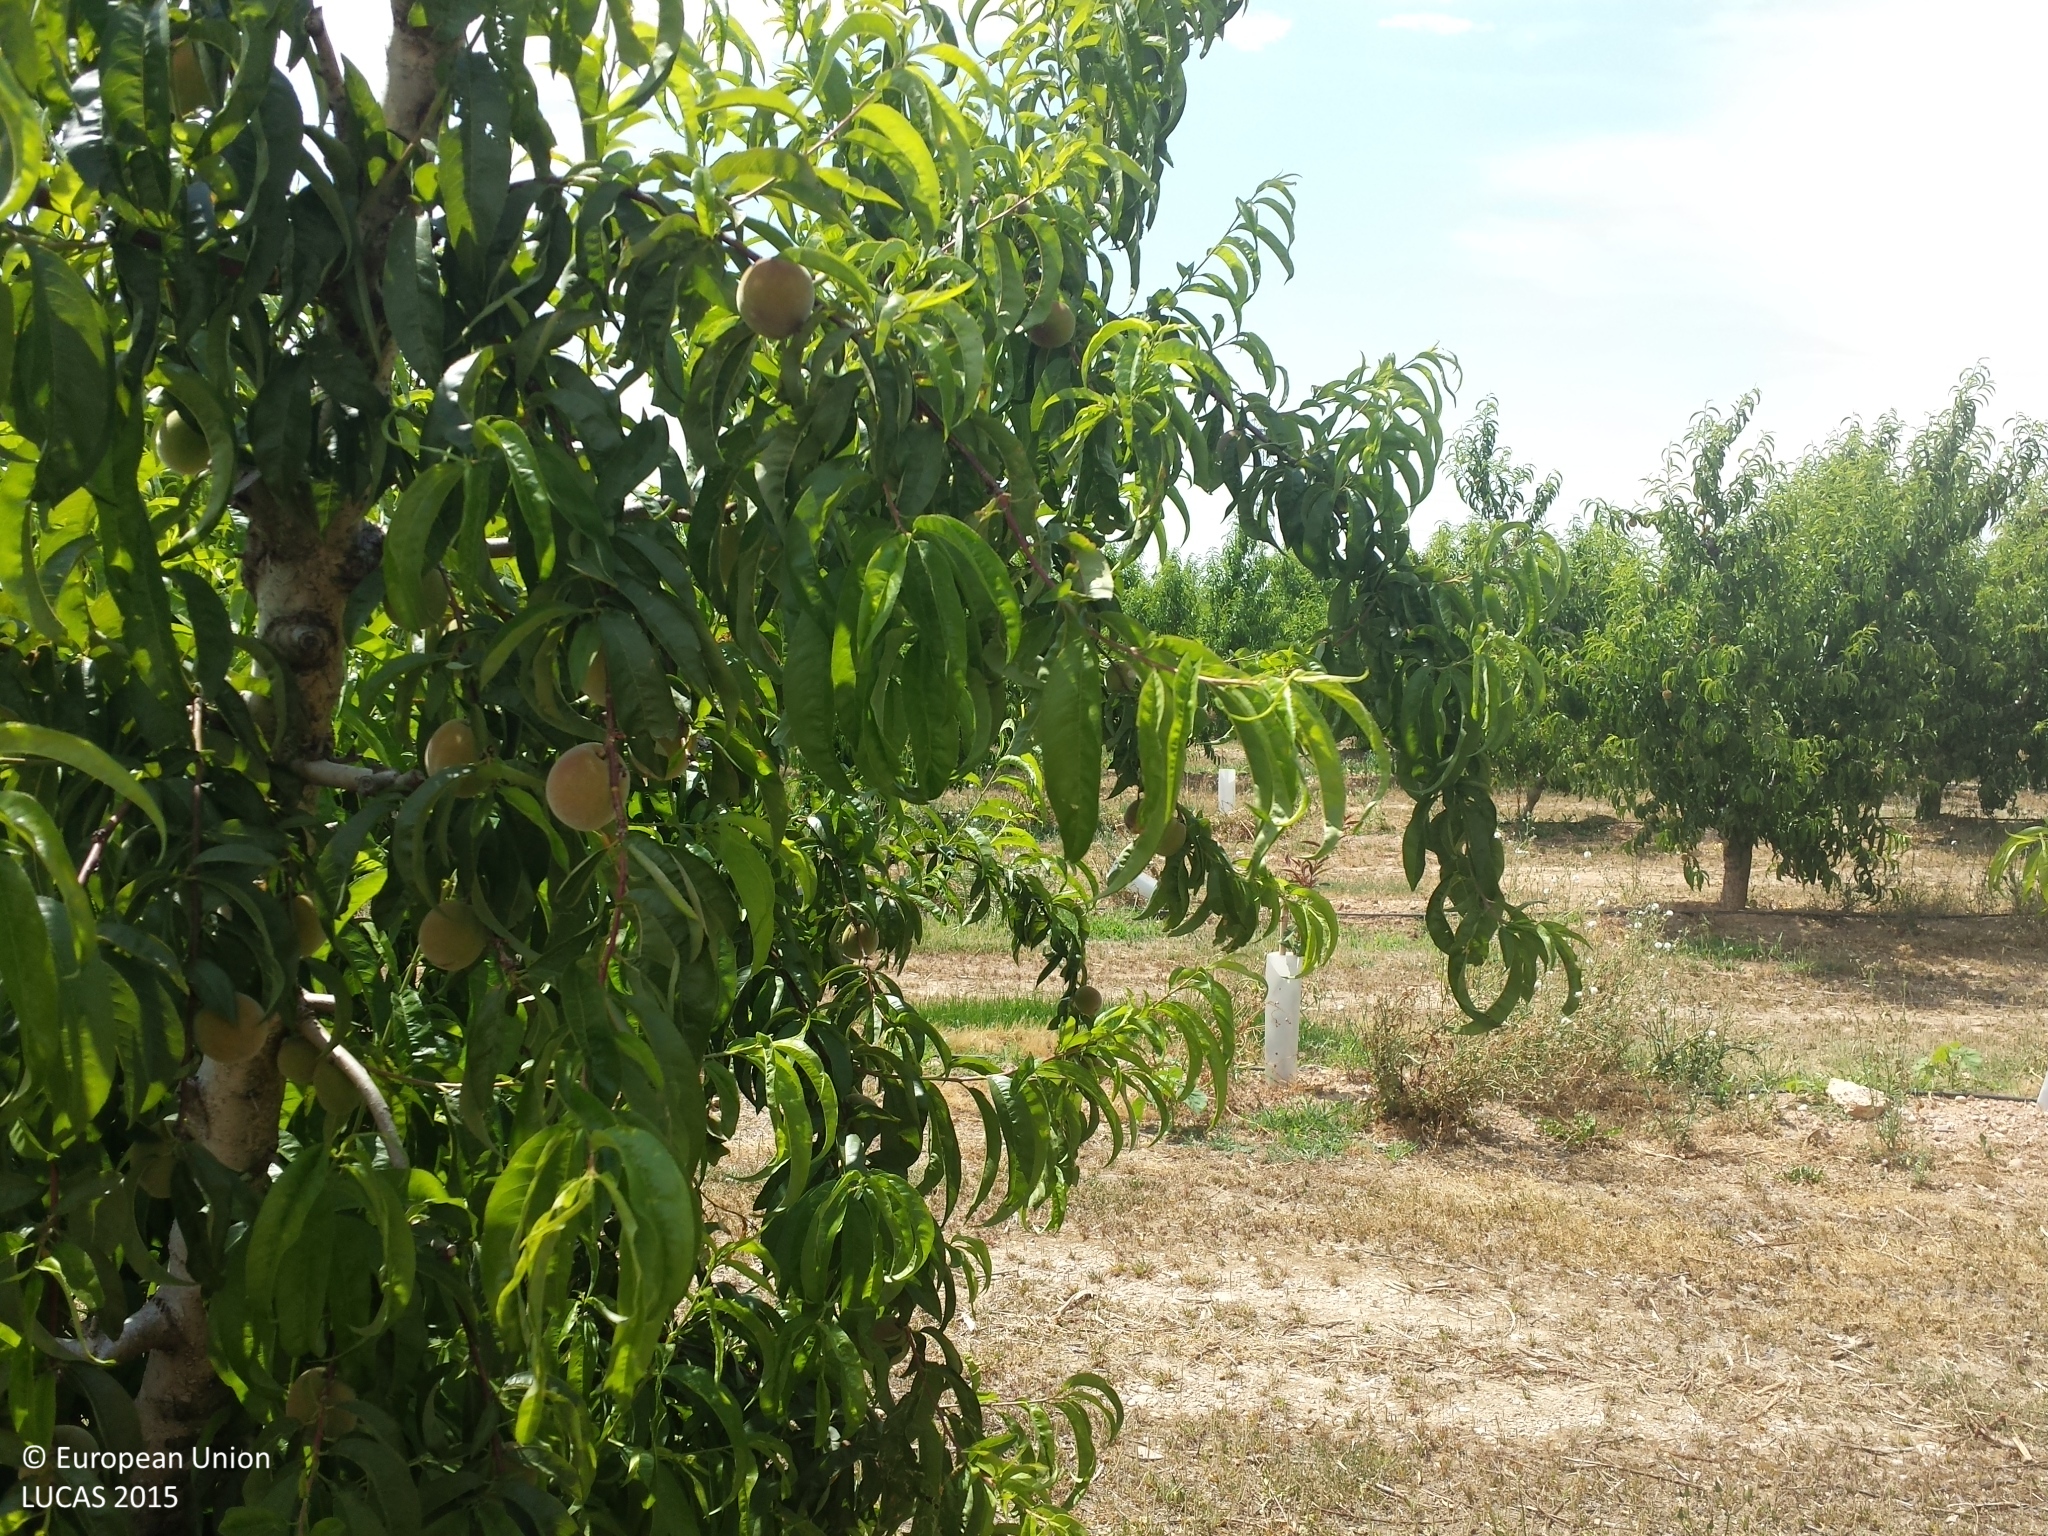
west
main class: Cropland
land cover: Other fruit trees and berries
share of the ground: 25 - 50 %
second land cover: Spontaneously vegetated surfaces
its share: 50 - 75 %
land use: Agriculture (excluding fallow land and kitchen gardens)
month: June
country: ES
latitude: 41.5392
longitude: 0.5544
